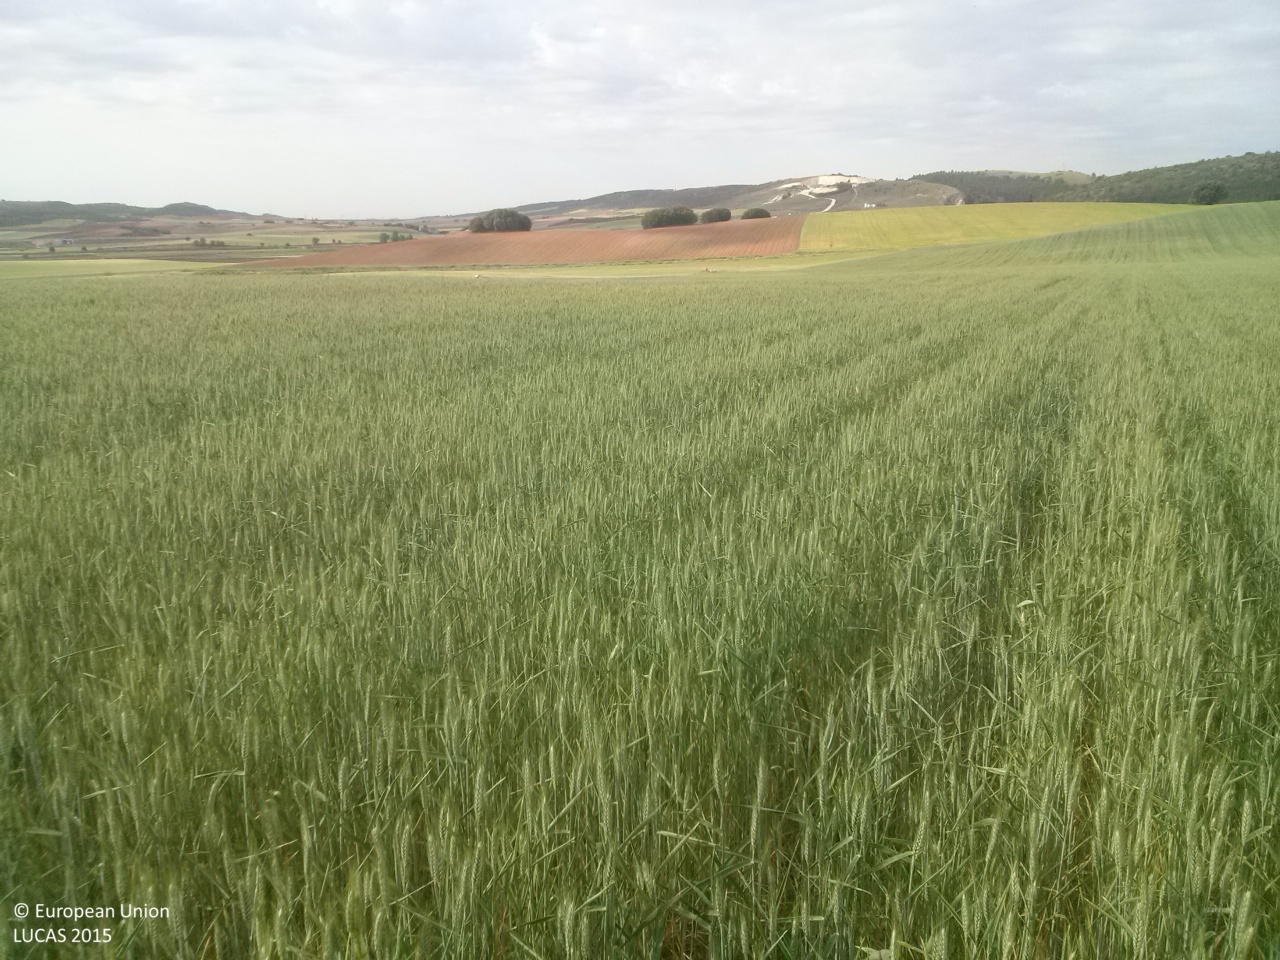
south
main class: Cropland
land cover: Common wheat
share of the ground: > 75 %
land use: Agriculture (excluding fallow land and kitchen gardens)
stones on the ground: < 10 %
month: May
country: ES
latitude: 40.0754
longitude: -2.8632
